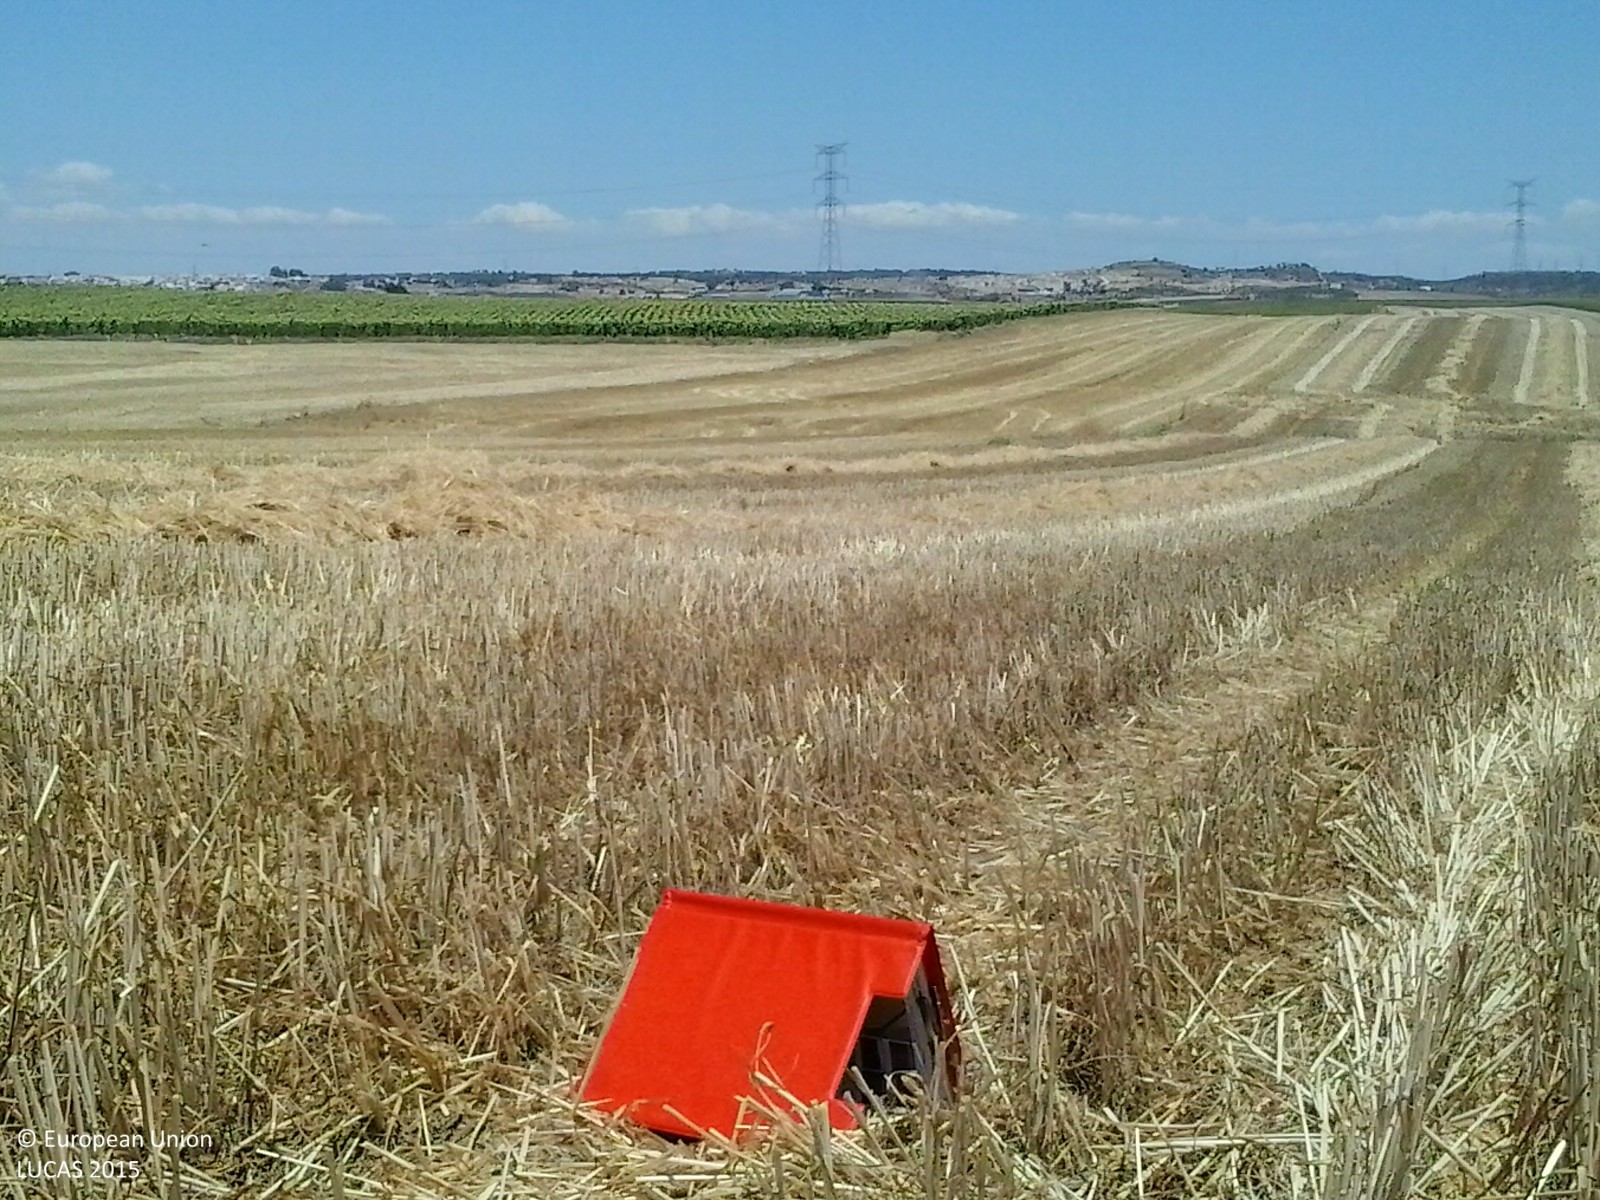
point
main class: Cropland
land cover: Common wheat
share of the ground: < 10 %
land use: Agriculture (excluding fallow land and kitchen gardens)
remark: Harvested field
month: June
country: ES
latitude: 37.5049
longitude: -6.1255
